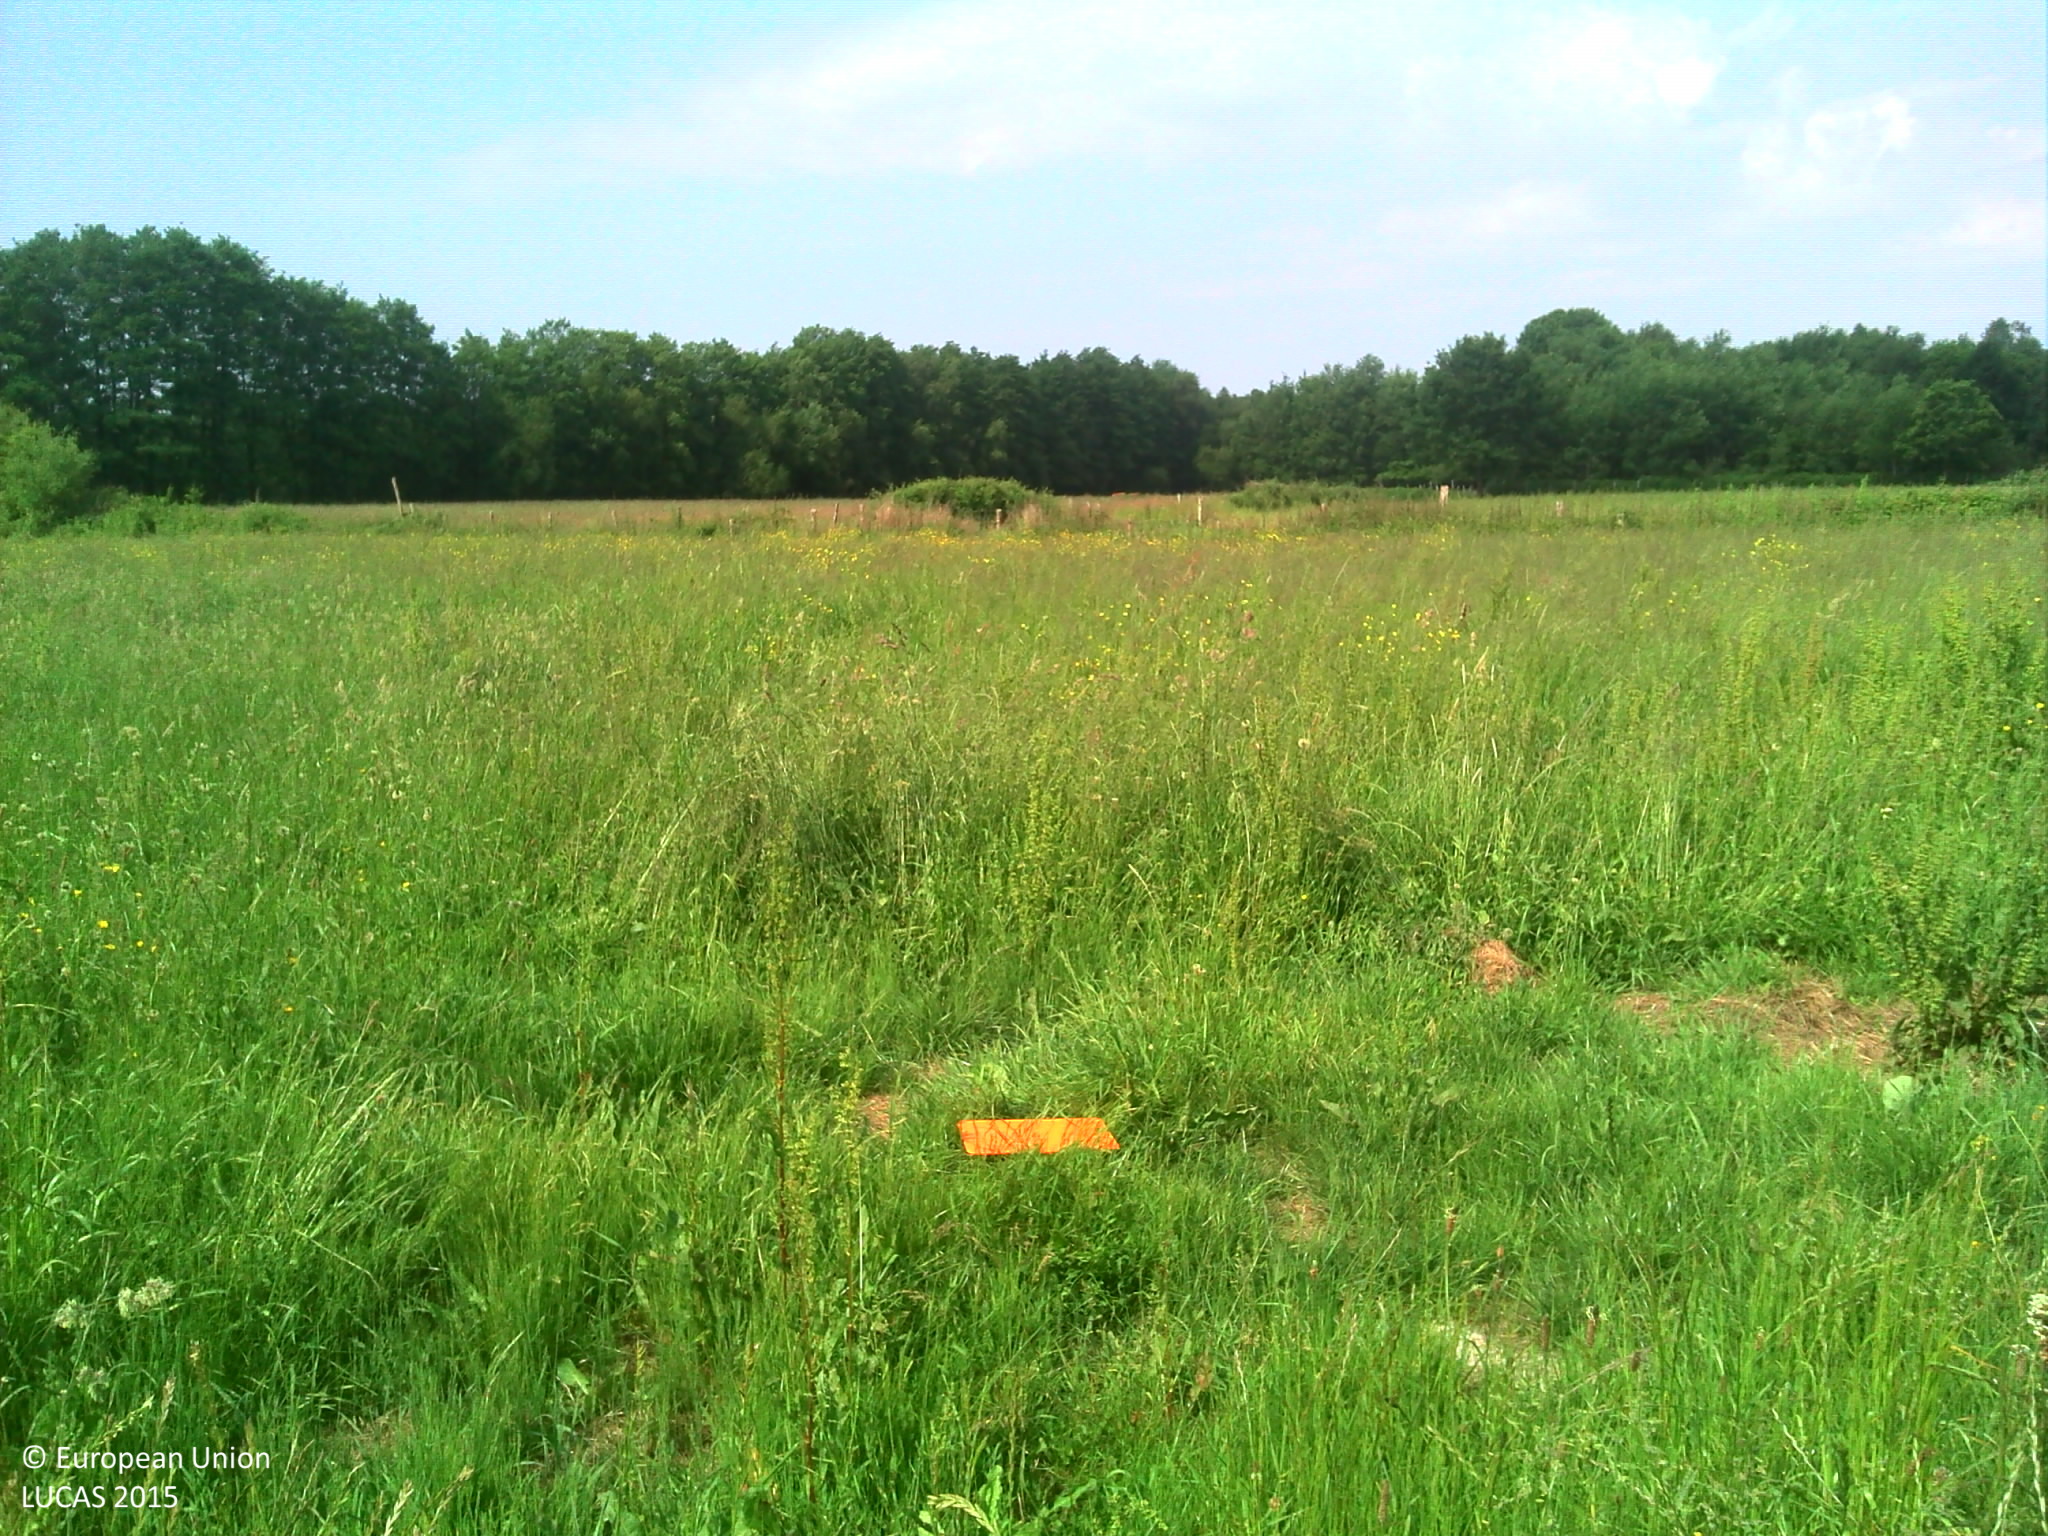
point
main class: Grassland
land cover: Grassland without tree/shrub cover
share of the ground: > 75 %
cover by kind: herbaceous plants 100 %
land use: Agriculture (excluding fallow land and kitchen gardens)
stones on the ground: < 10 %
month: June
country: FR
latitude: 47.8597
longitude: 0.0147
